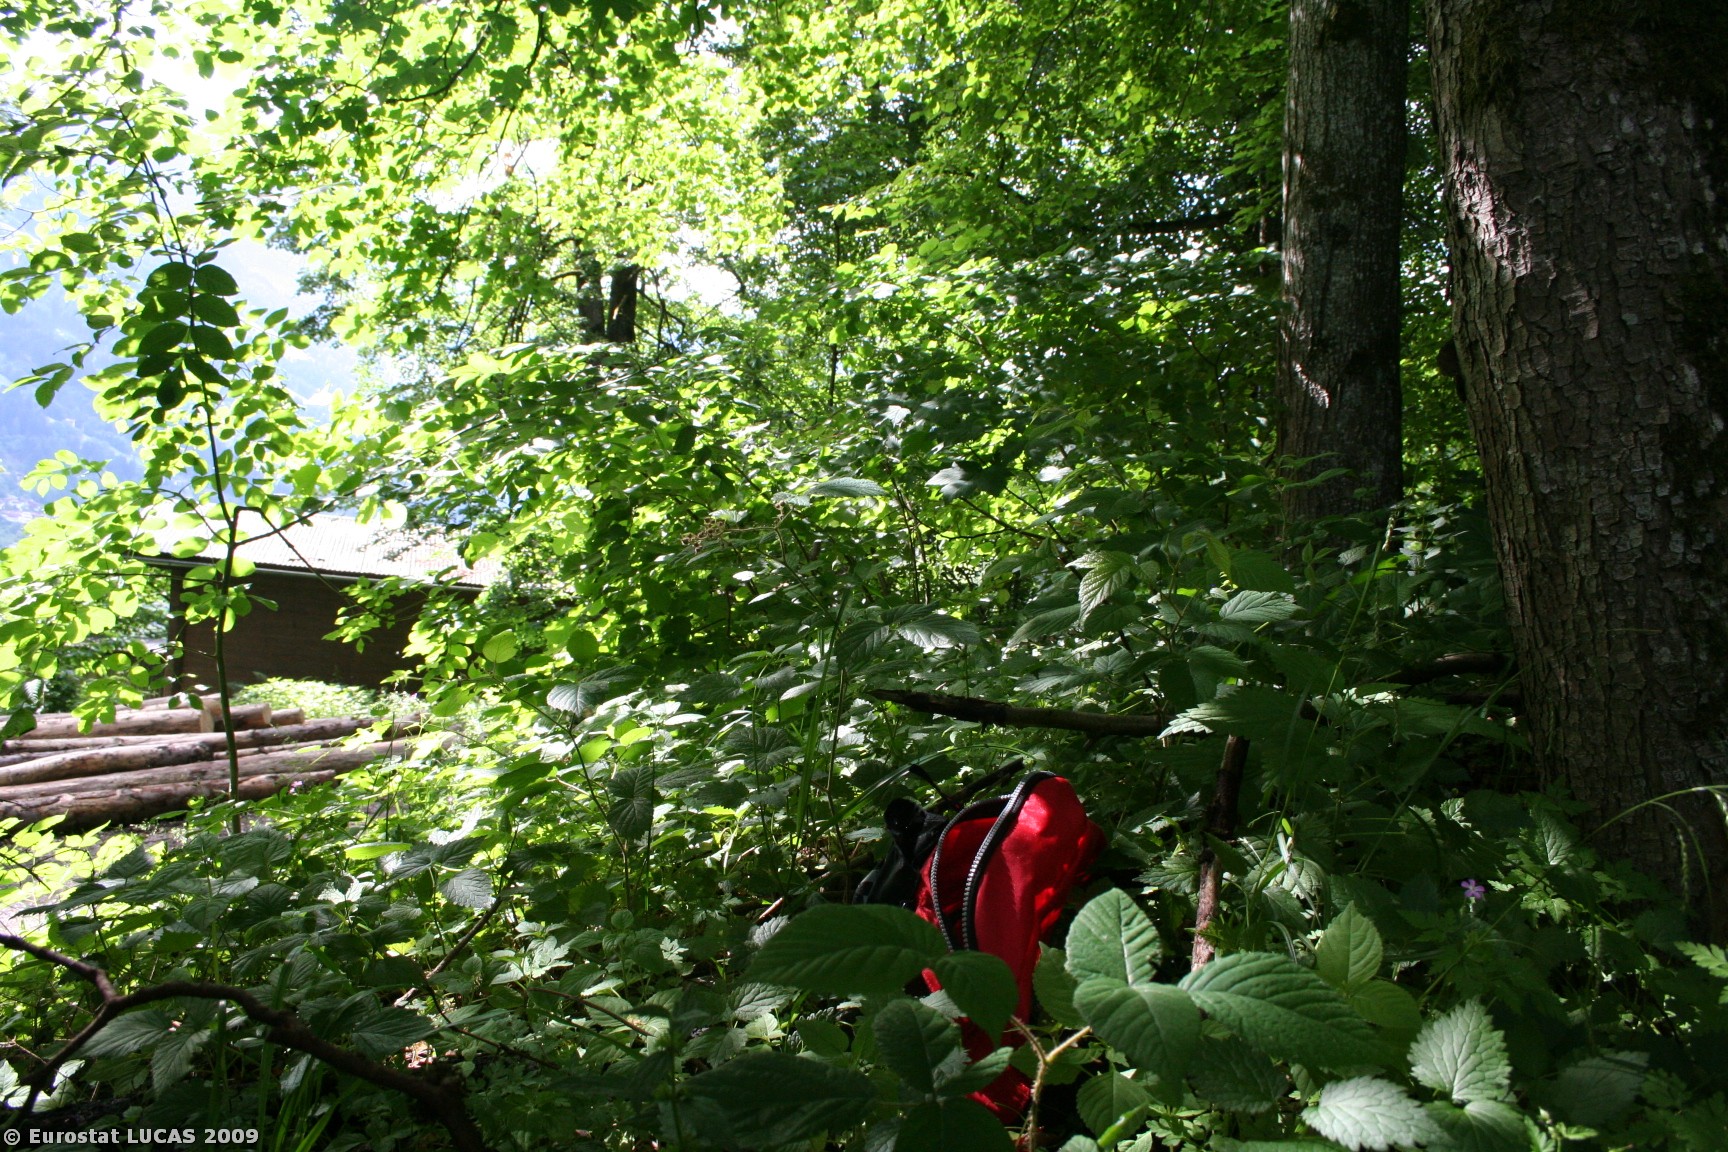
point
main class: Woodland
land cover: Broadleaved woodland
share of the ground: > 75 %
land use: Forestry
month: June
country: AT
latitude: 47.2176
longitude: 11.8602
